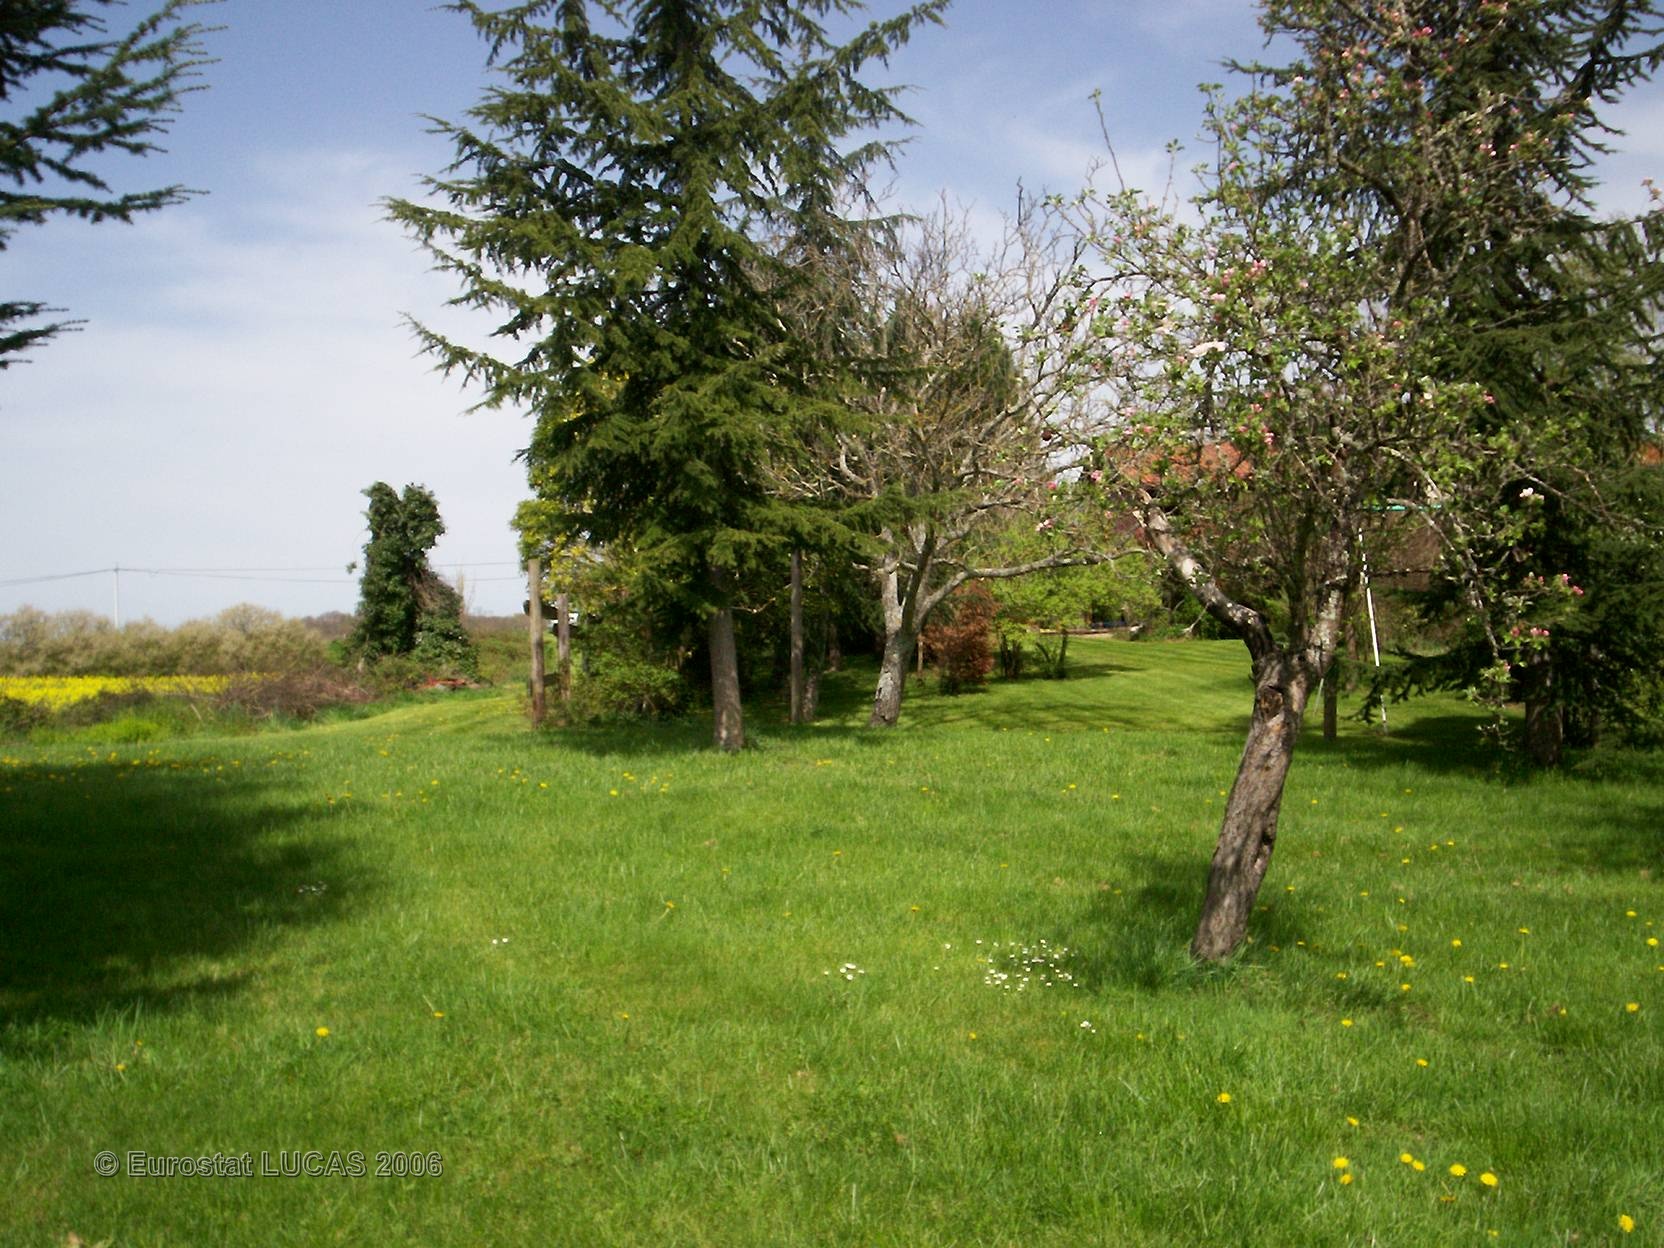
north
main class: Grassland
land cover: Grassland with sparse tree/shrub cover
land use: Residential
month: April
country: FR
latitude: 43.4184
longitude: 0.2521
